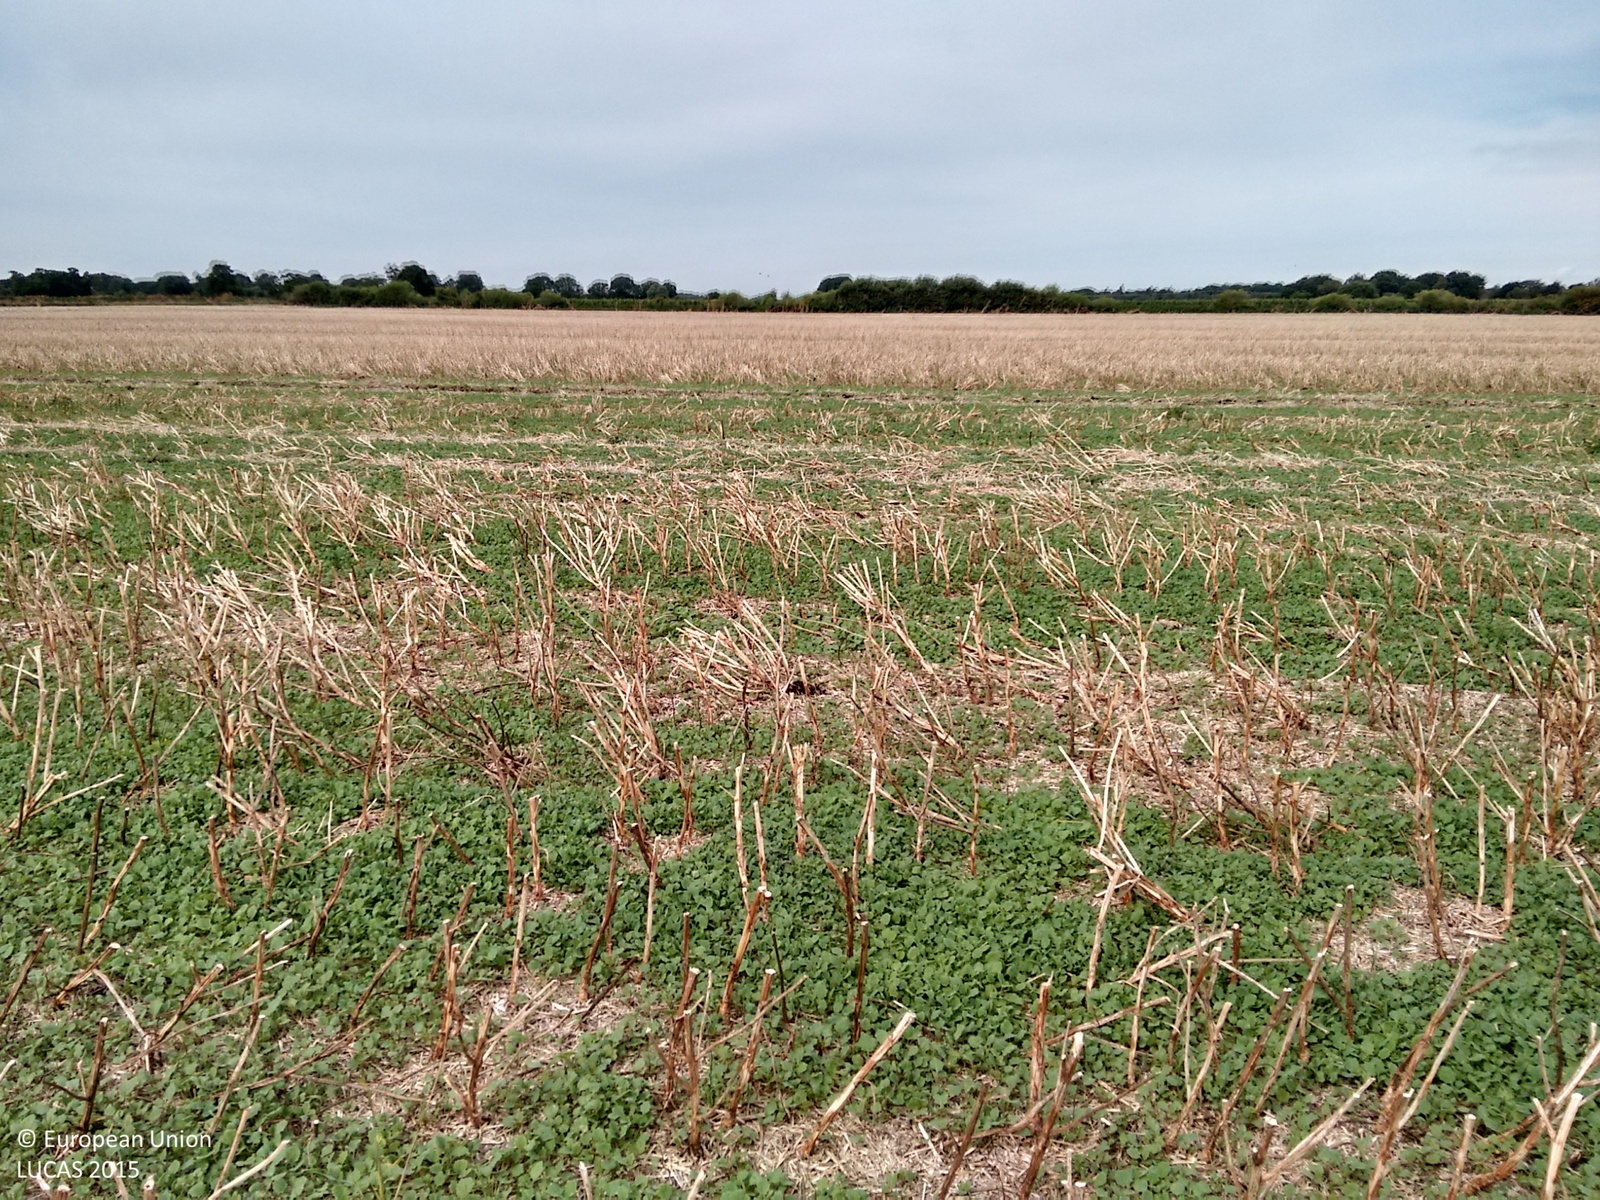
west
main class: Cropland
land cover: Rape and turnip rape
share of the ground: > 75 %
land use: Agriculture (excluding fallow land and kitchen gardens)
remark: Harvested field
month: August
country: GB
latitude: 52.5336
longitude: 0.4338
